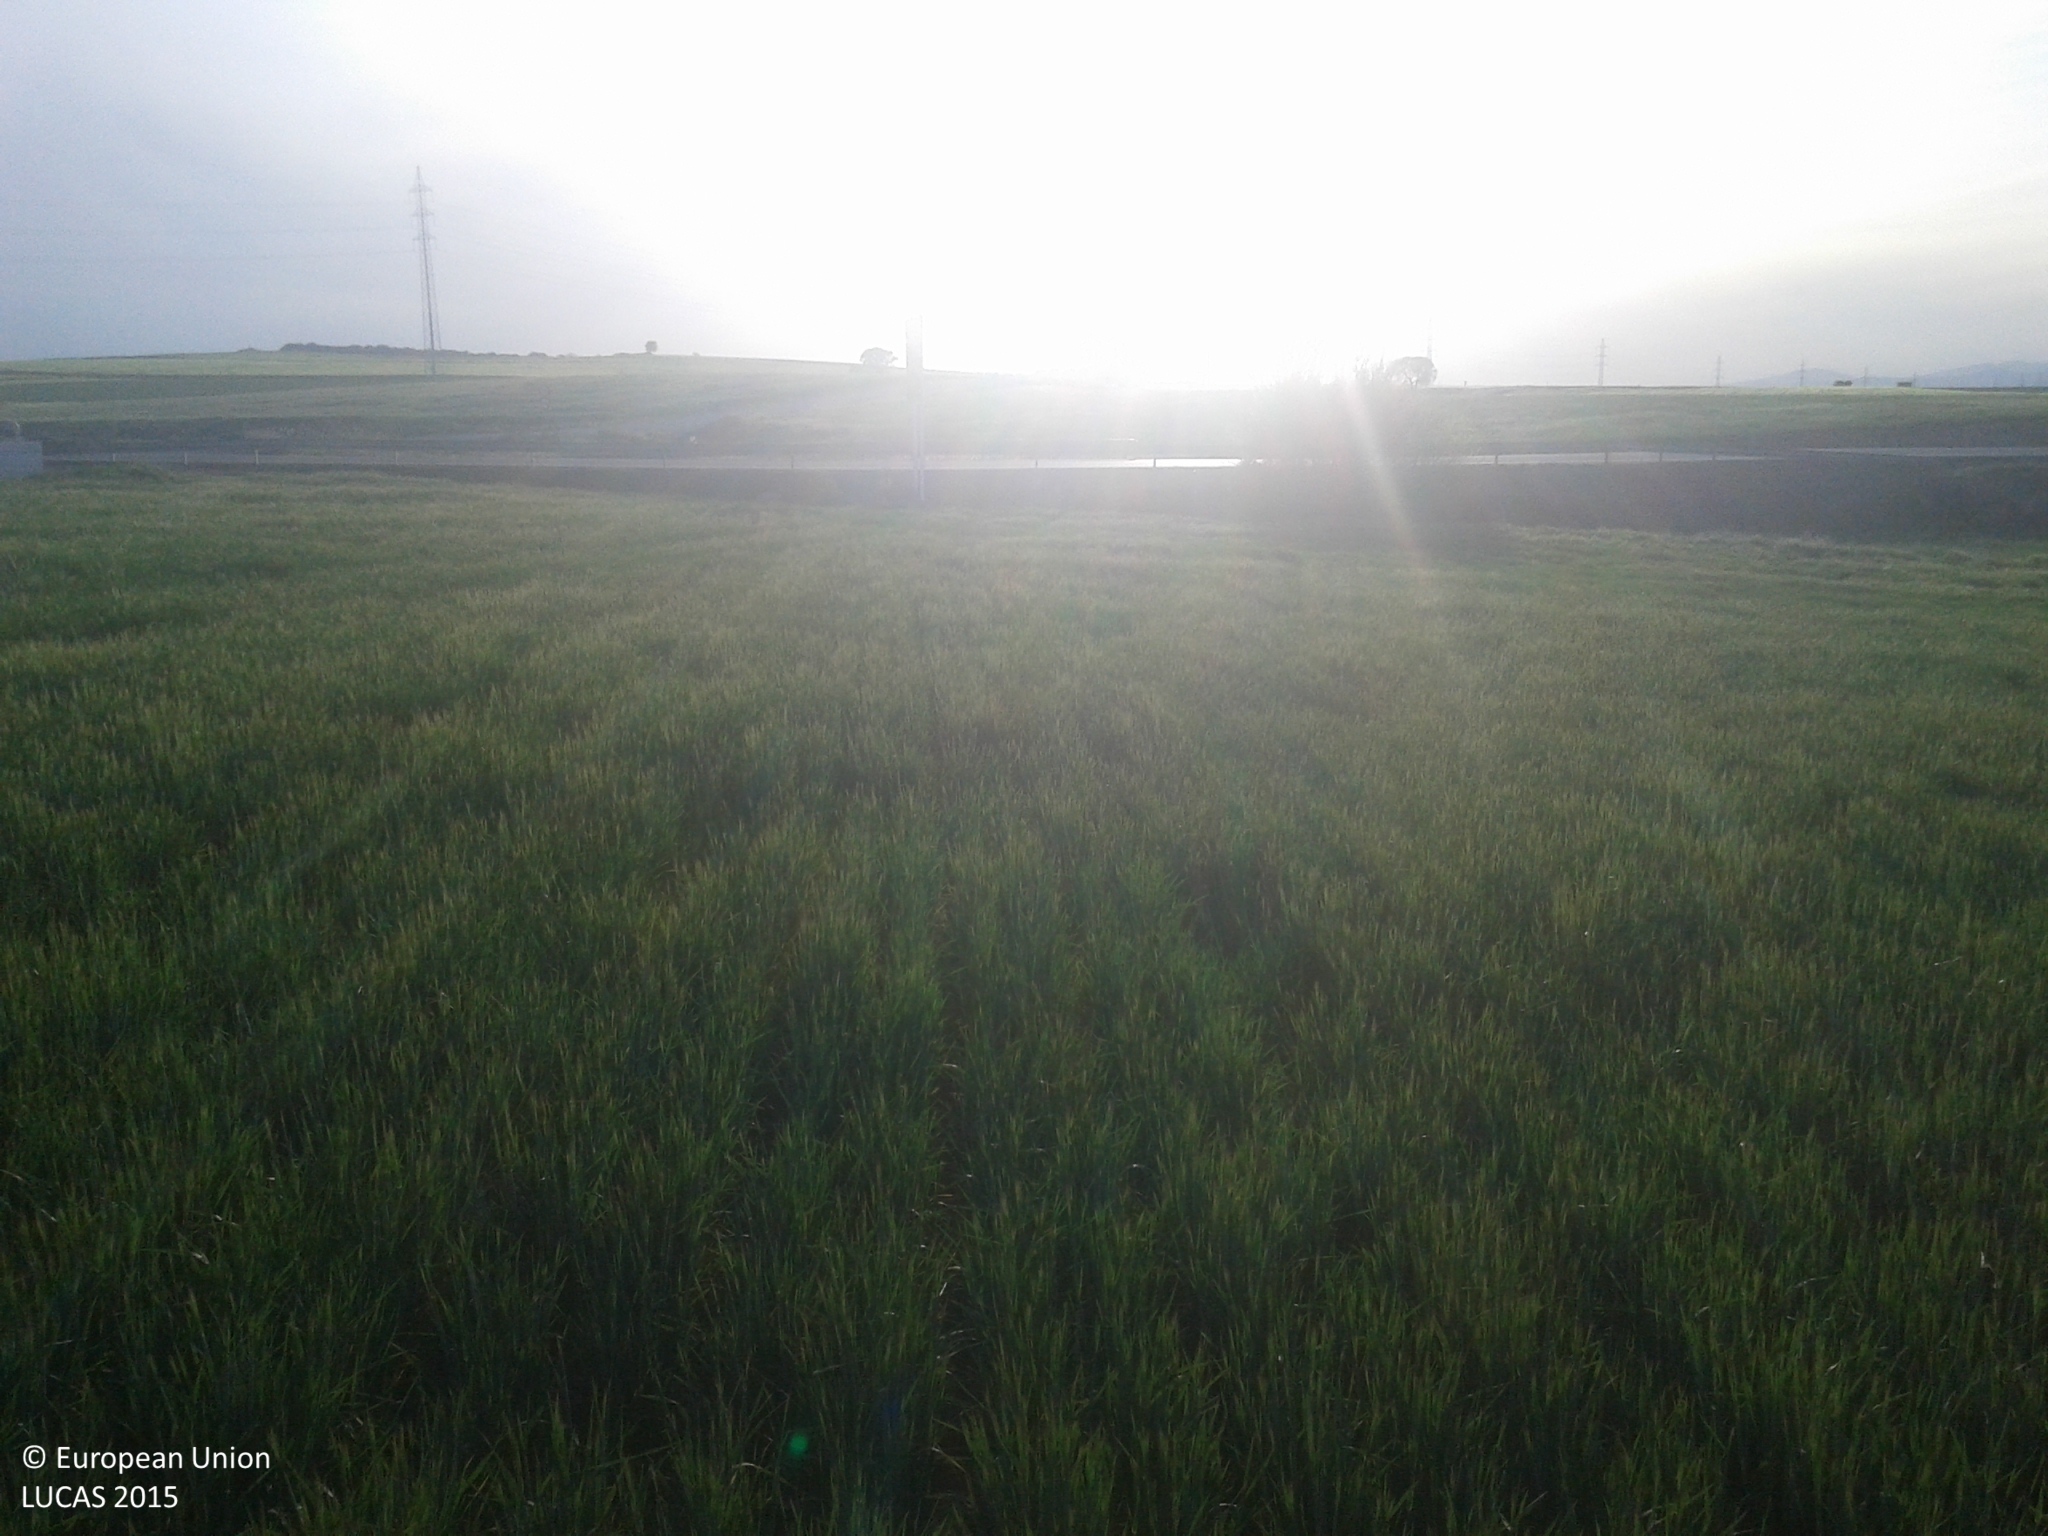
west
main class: Cropland
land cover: Rye
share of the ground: > 75 %
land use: Agriculture (excluding fallow land and kitchen gardens)
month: April
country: ES
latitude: 41.7710
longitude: 1.0985
